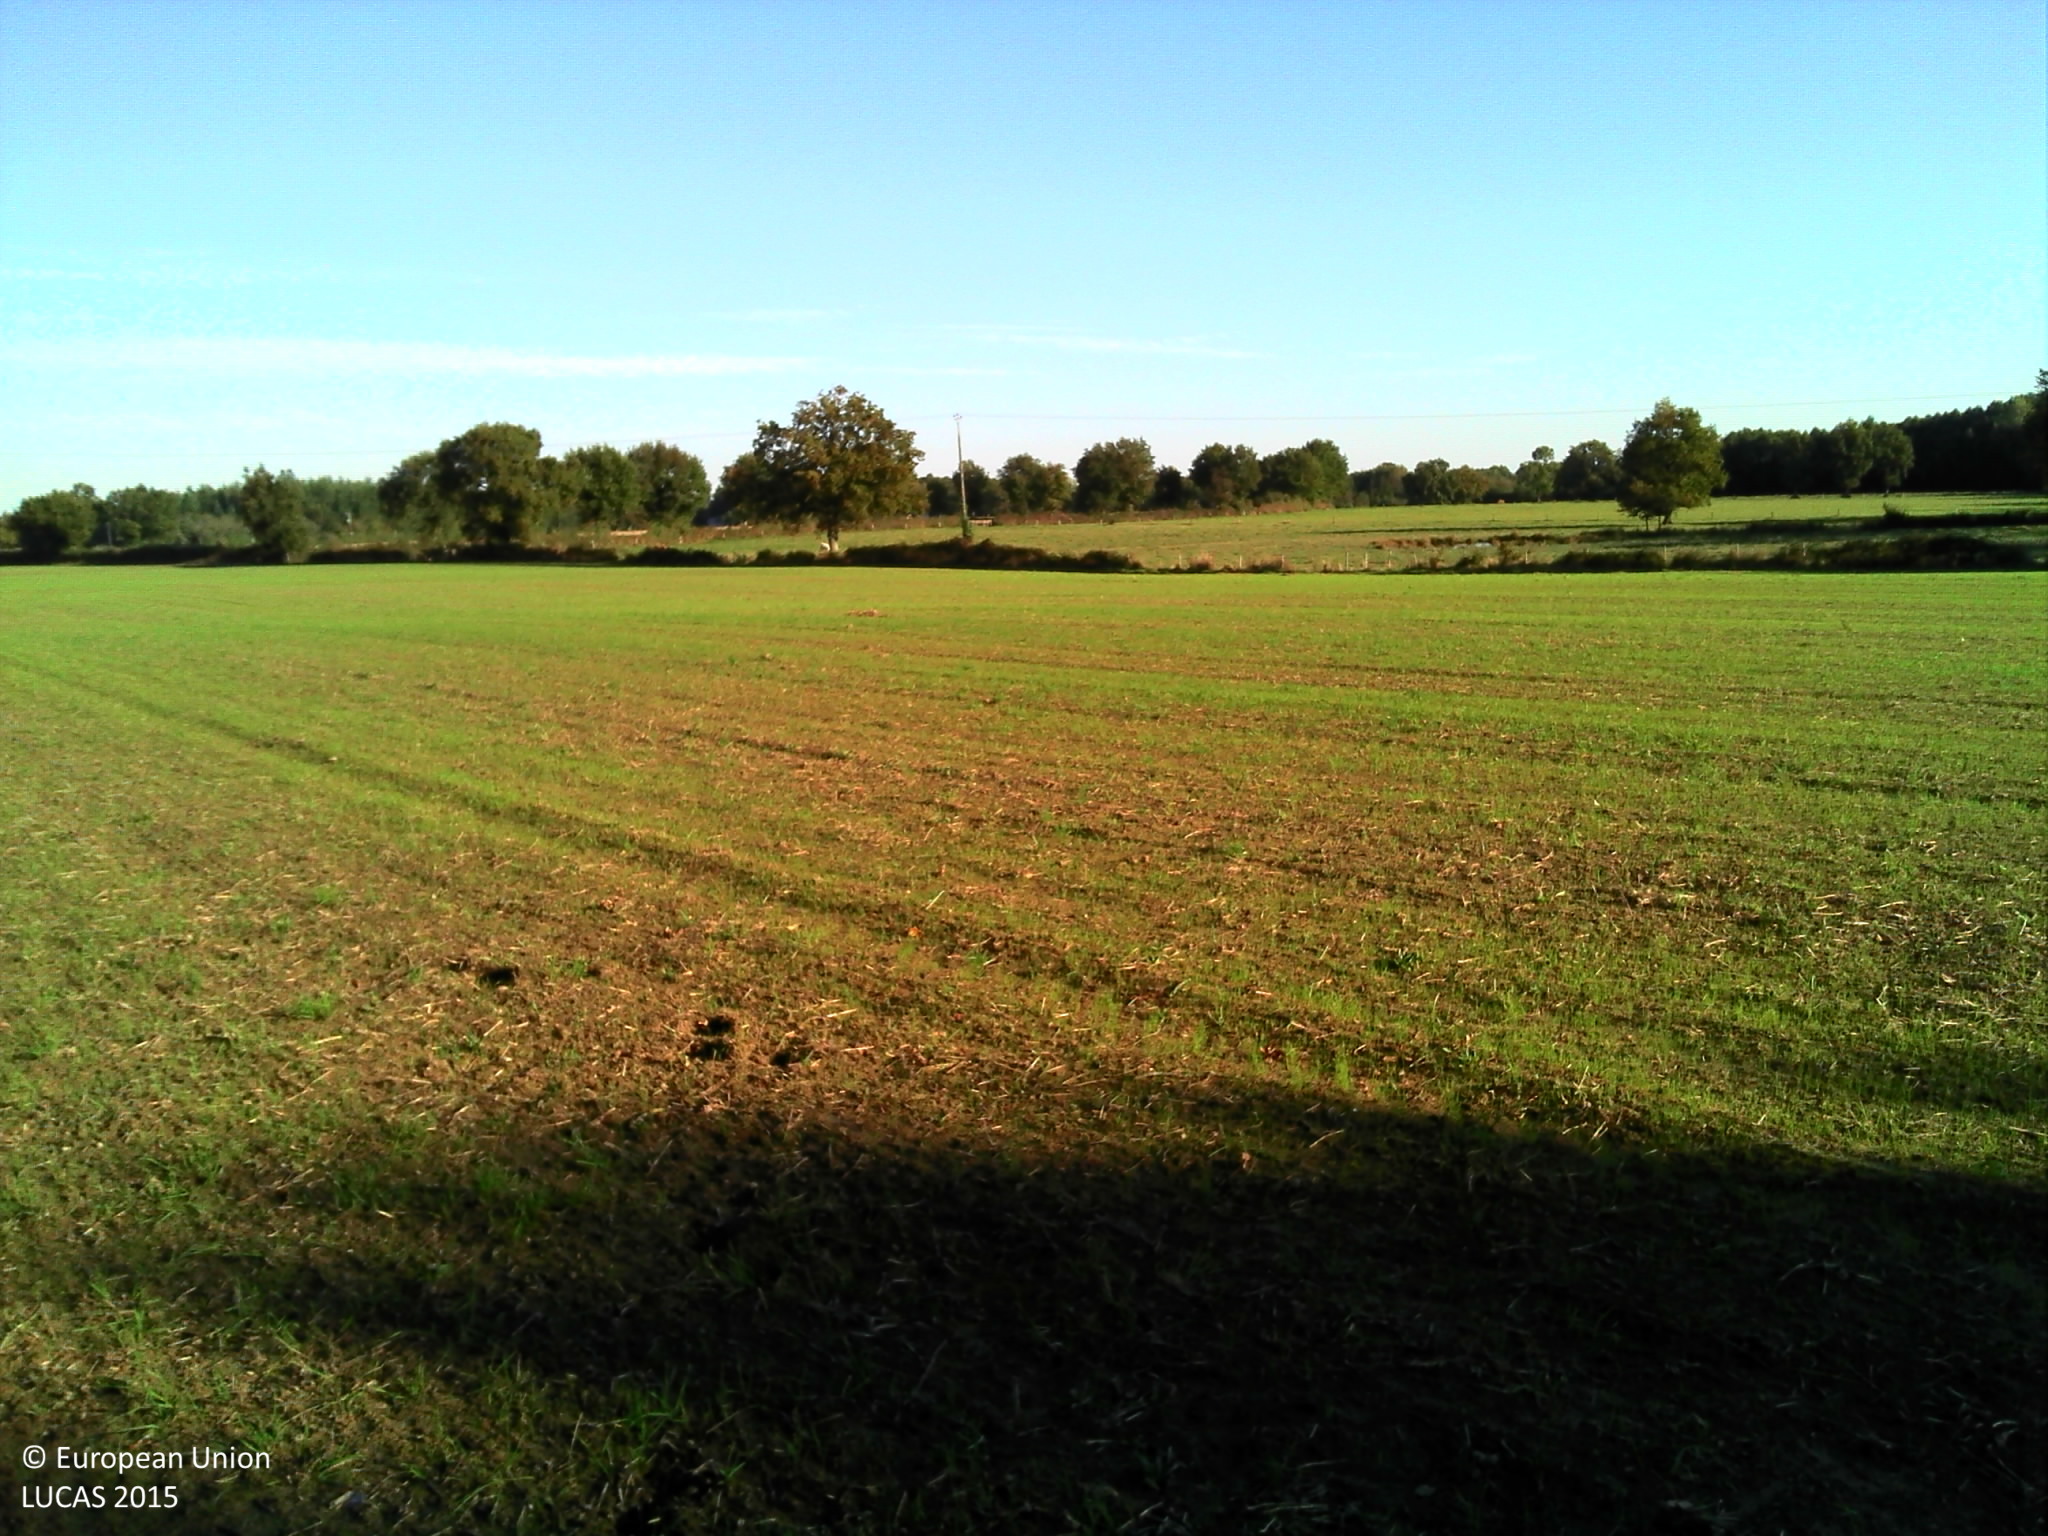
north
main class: Cropland
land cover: Common wheat
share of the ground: > 75 %
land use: Agriculture (excluding fallow land and kitchen gardens)
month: September
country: FR
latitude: 46.5757
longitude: -1.4021
